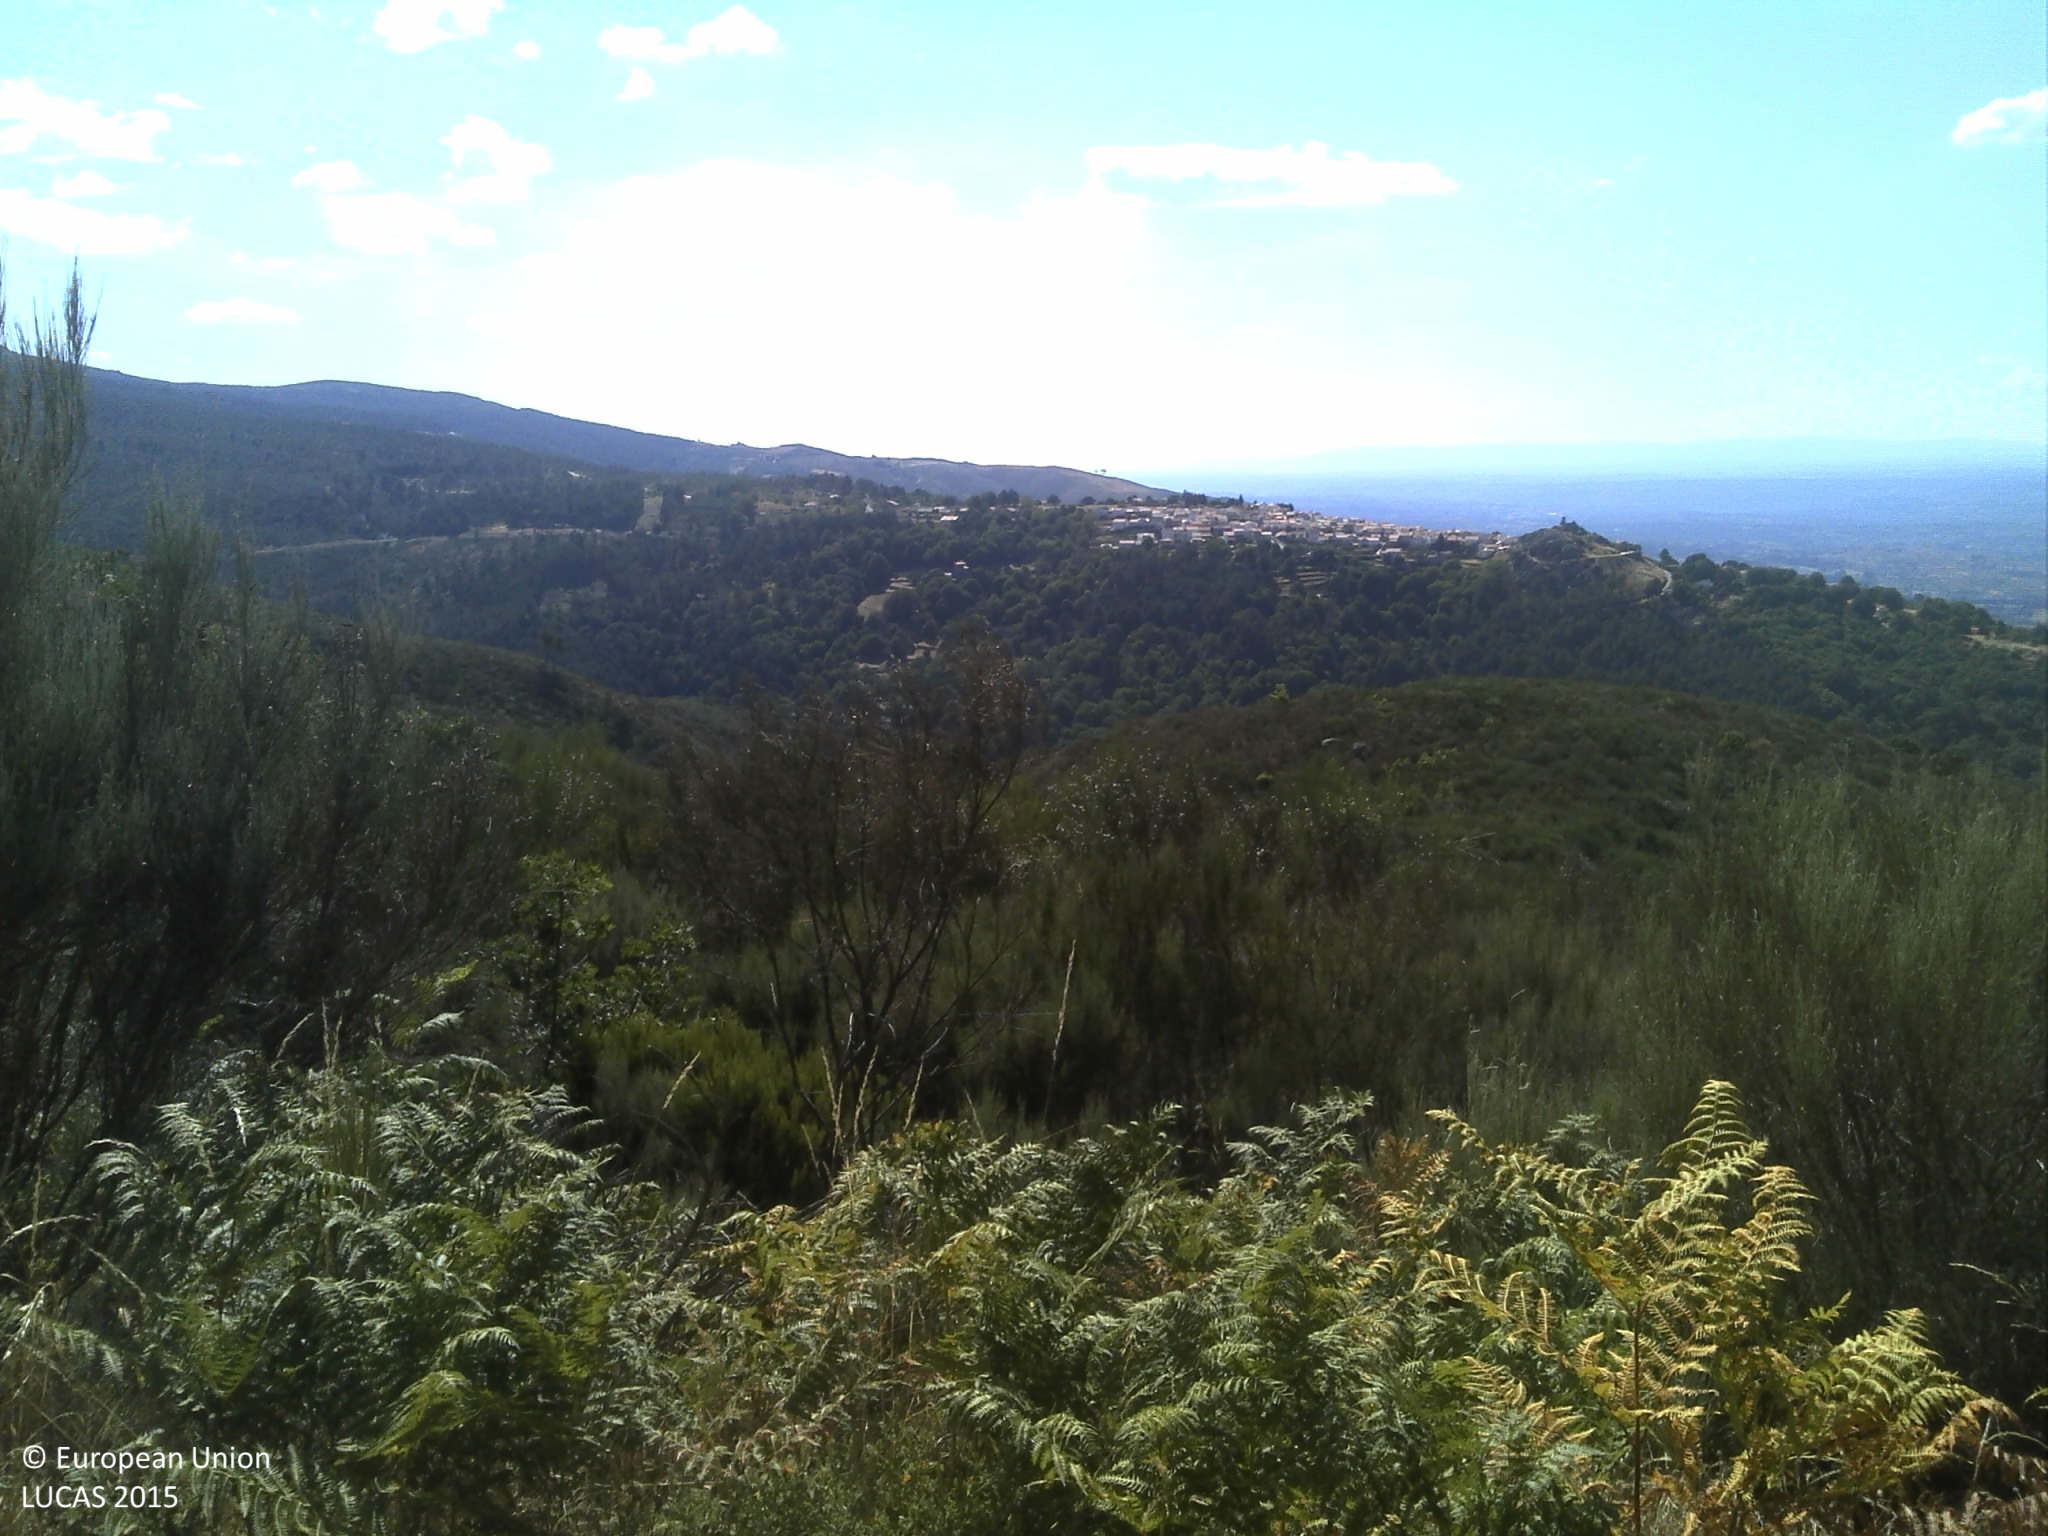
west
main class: Shrubland
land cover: Shrubland without tree cover
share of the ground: 25 - 50 %
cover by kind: shrubs 45 %, unconsolidated bare surface 30 %, herbaceous plants 15 %
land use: Semi-natural and natural areas not in use
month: August
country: PT
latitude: 40.5088
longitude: -7.4943
